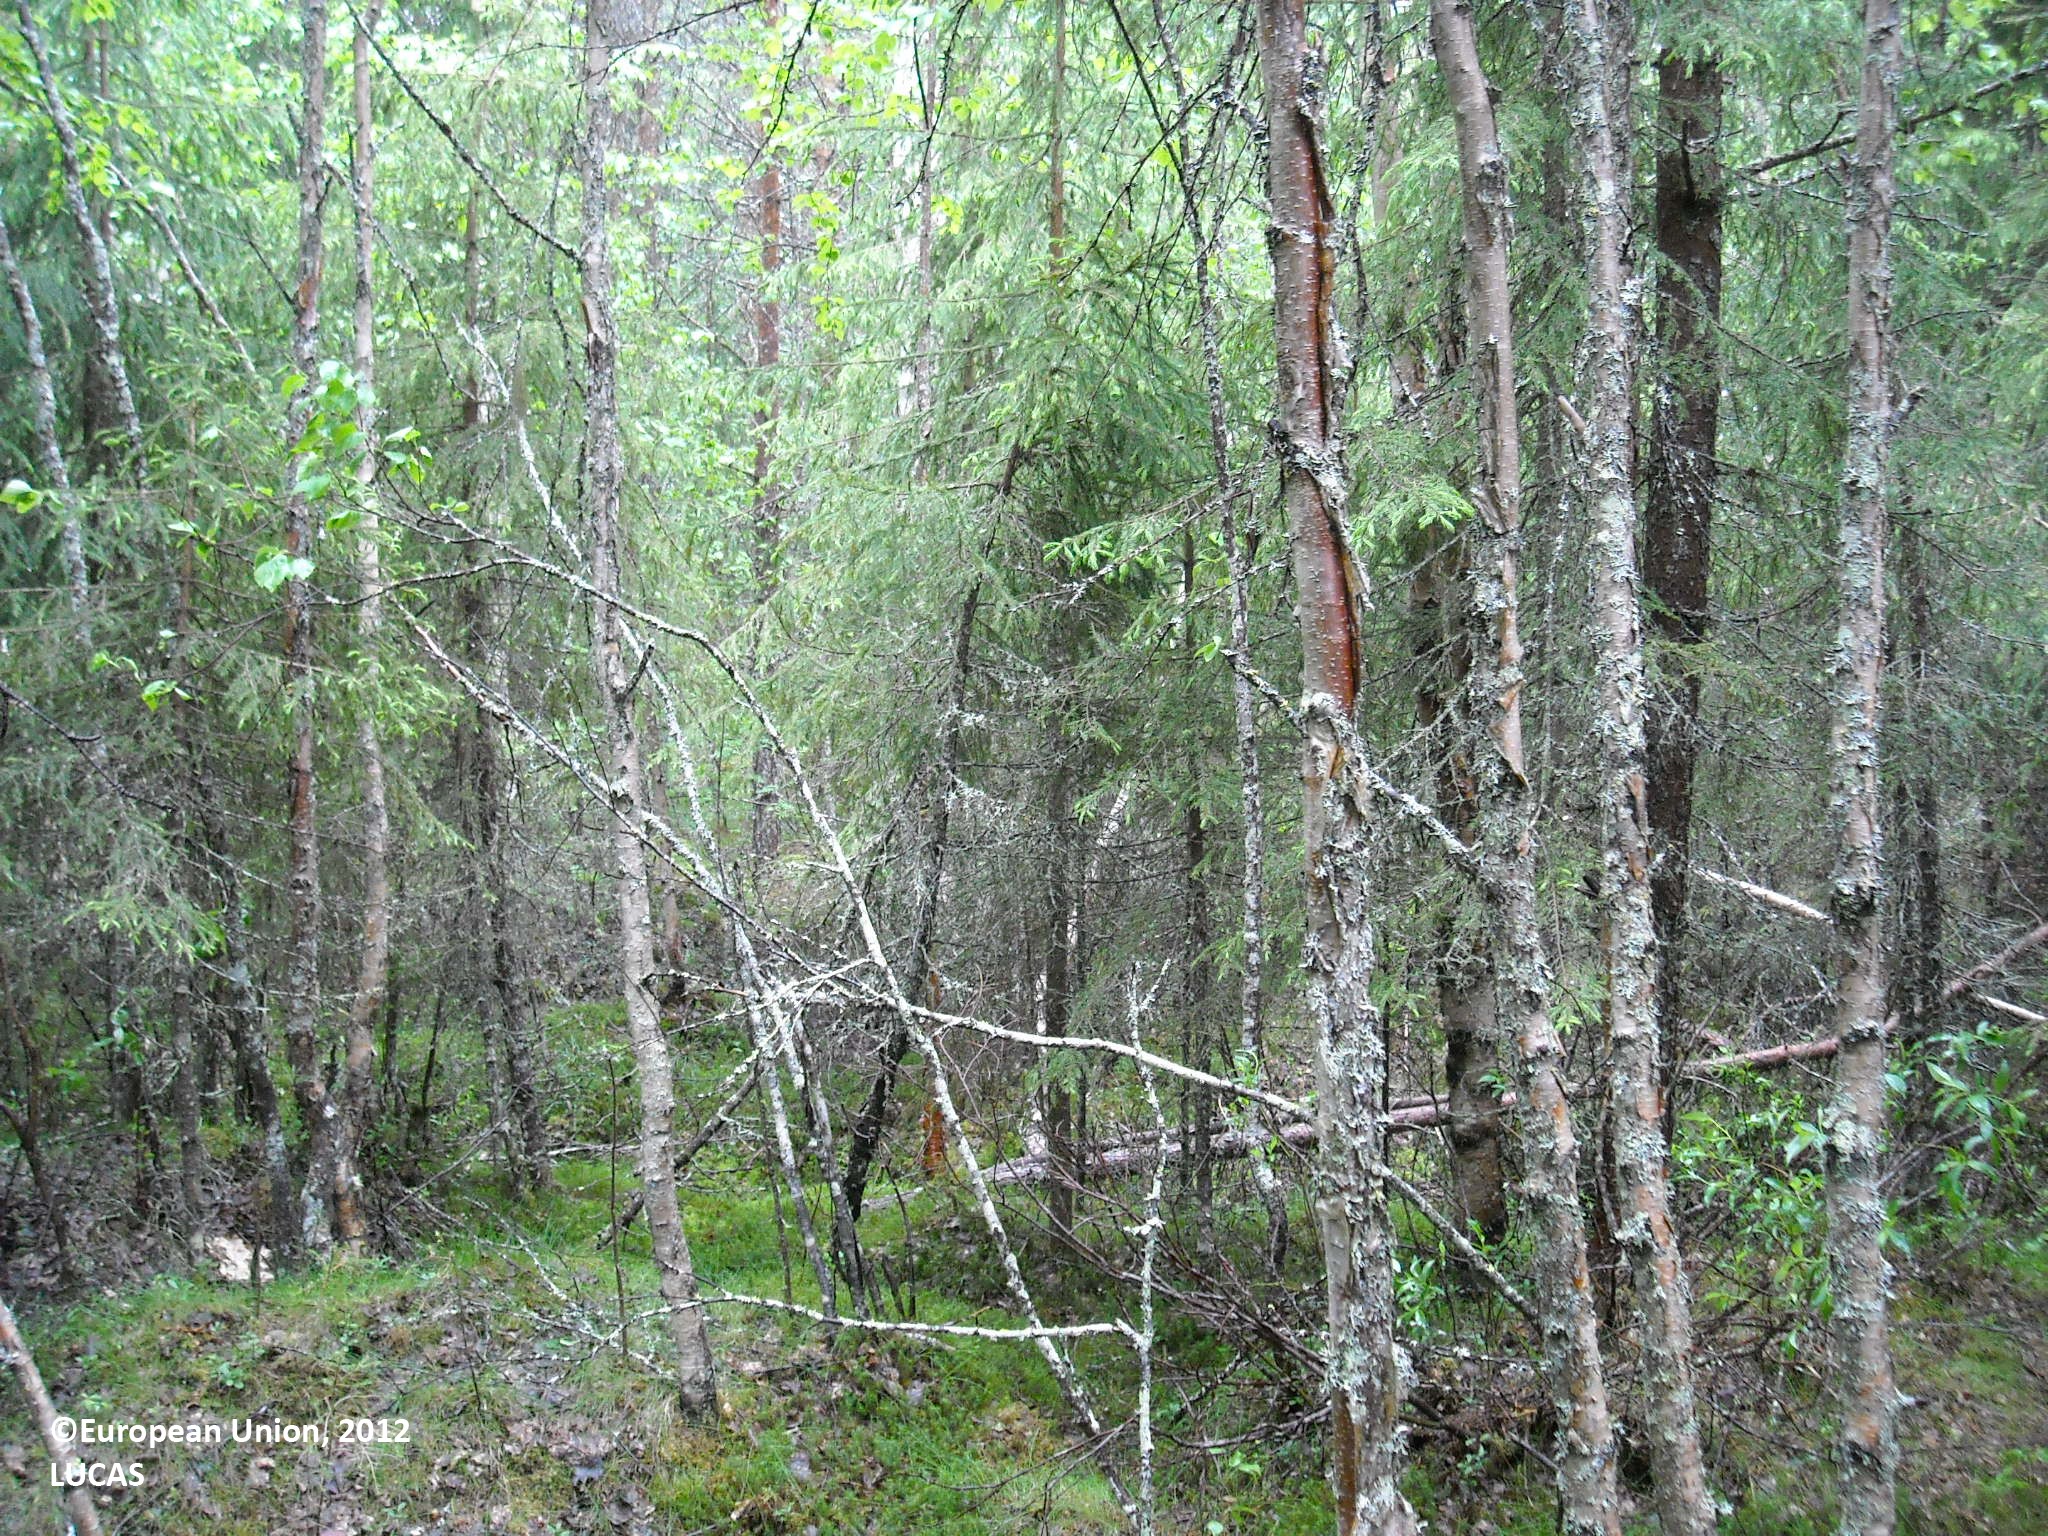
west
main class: Woodland
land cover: Other mixed woodland
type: boreal forest
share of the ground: > 75 %
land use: Forestry
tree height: > 5 m
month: June
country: FI
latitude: 65.4728
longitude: 27.9100
